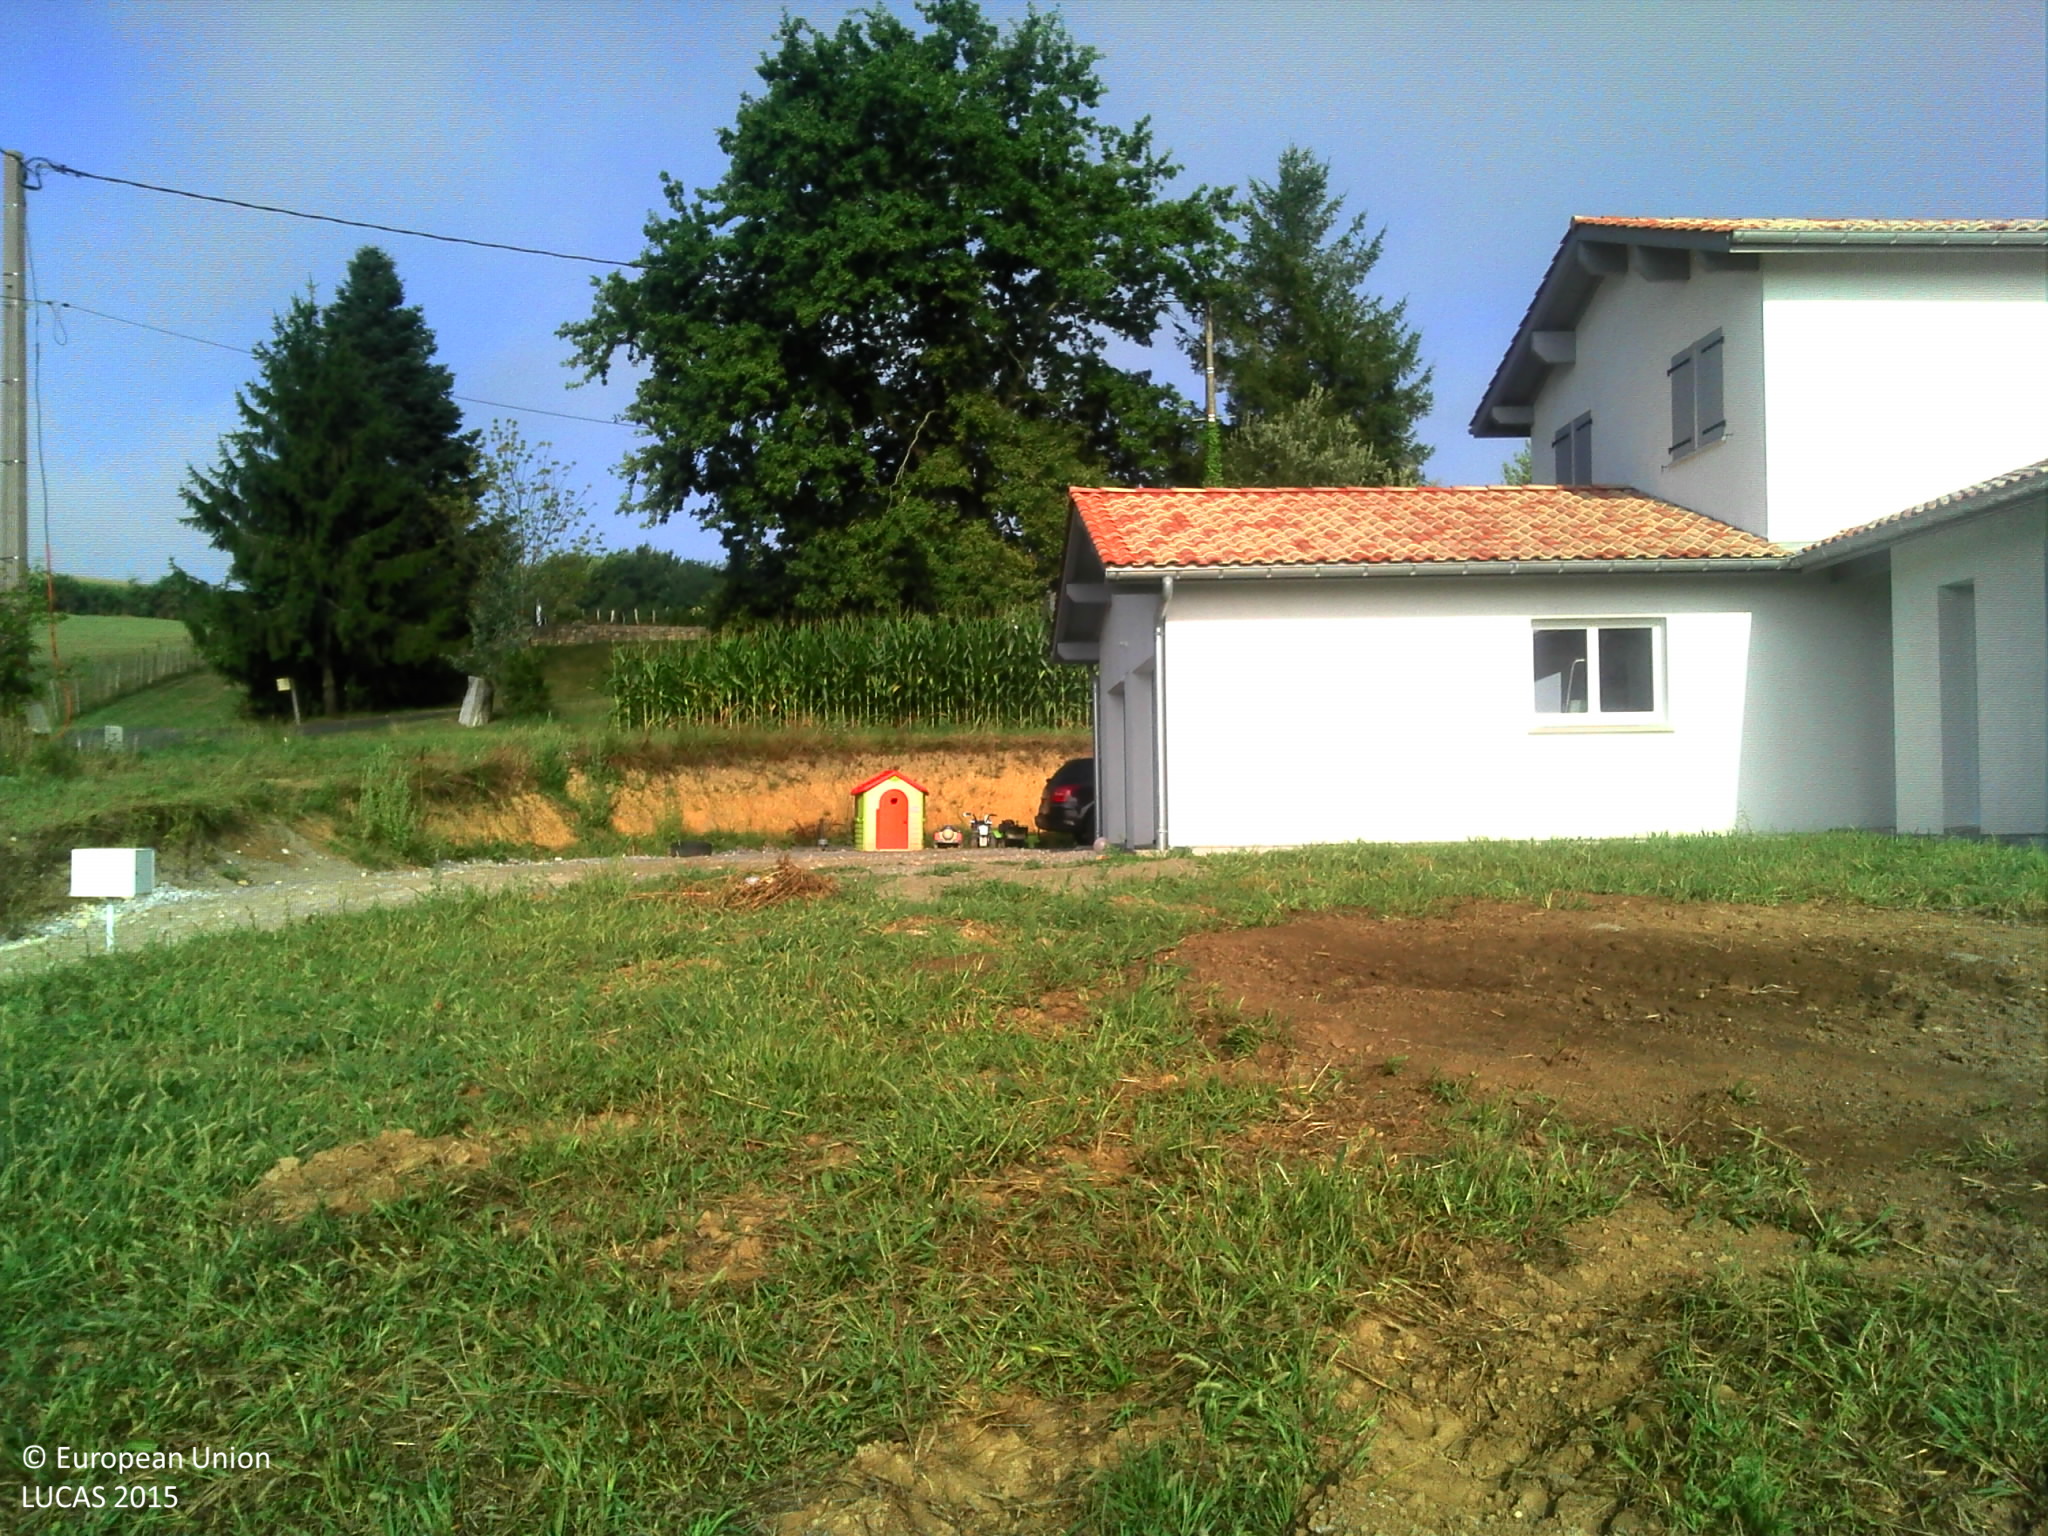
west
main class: Grassland
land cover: Grassland without tree/shrub cover
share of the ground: > 75 %
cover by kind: herbaceous plants 100 %
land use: Residential
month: August
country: FR
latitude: 43.5074
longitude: -1.1847
